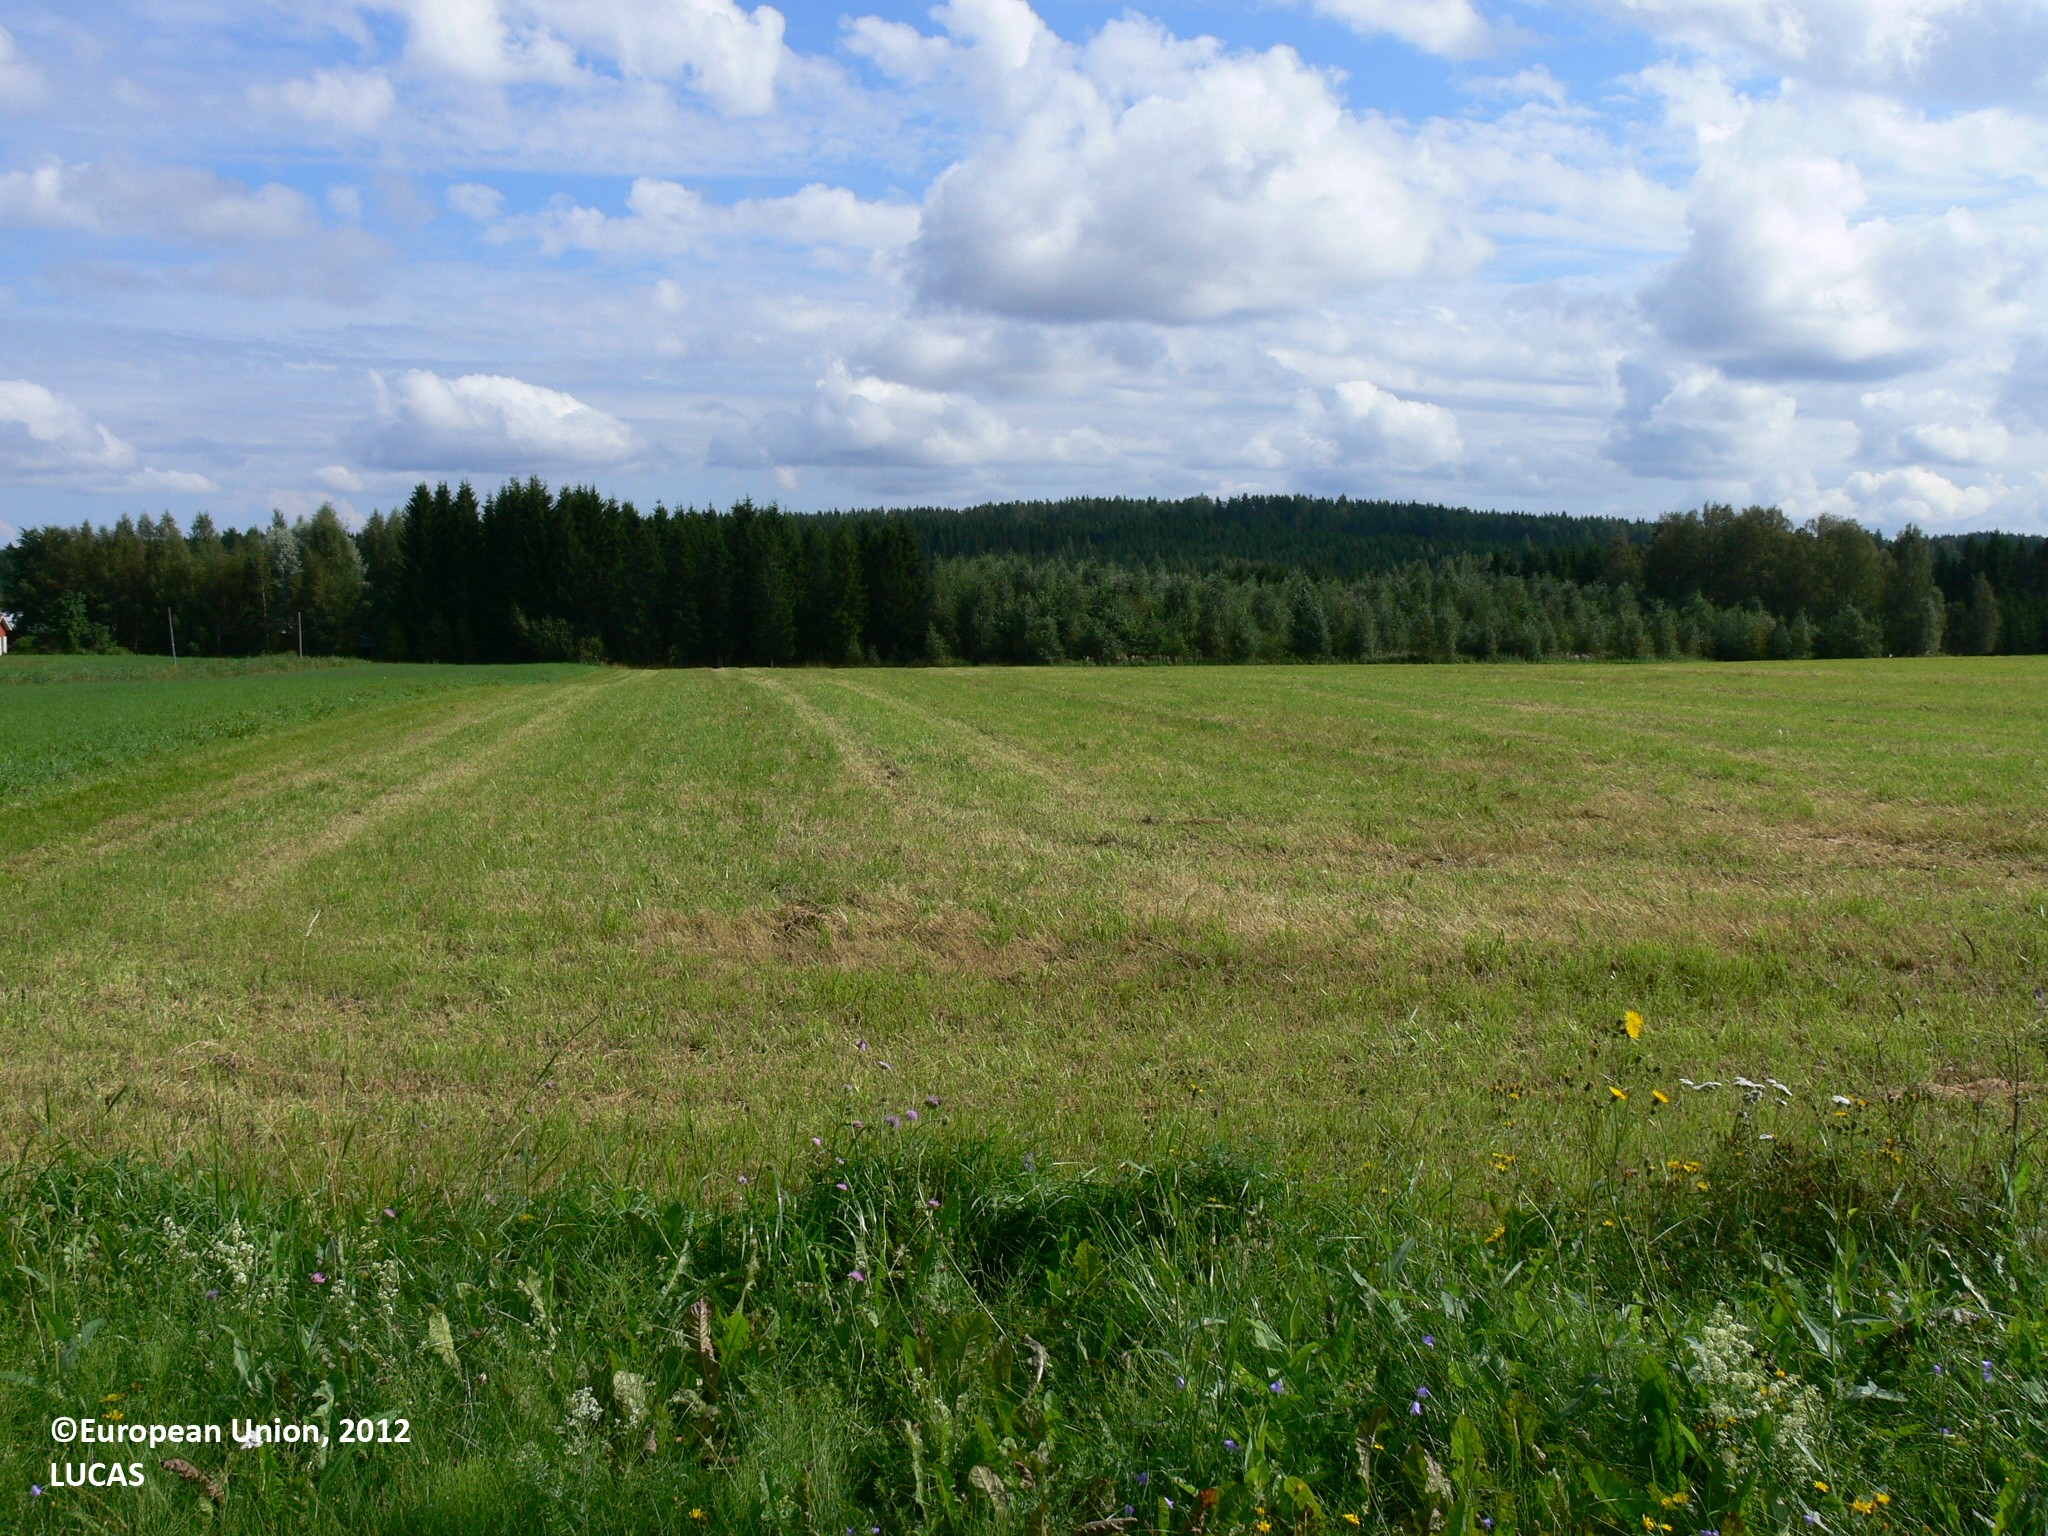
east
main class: Cropland
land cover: Temporary grasslands
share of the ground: 25 - 50 %
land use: Agriculture (excluding fallow land and kitchen gardens)
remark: Harvested field
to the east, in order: Temporary grasslands; Ditches and canals; Grass margins; Paved roads, cycling and walking lanes; Grass margins; Temporary grasslands
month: August
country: FI
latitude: 61.6655
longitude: 29.8099
